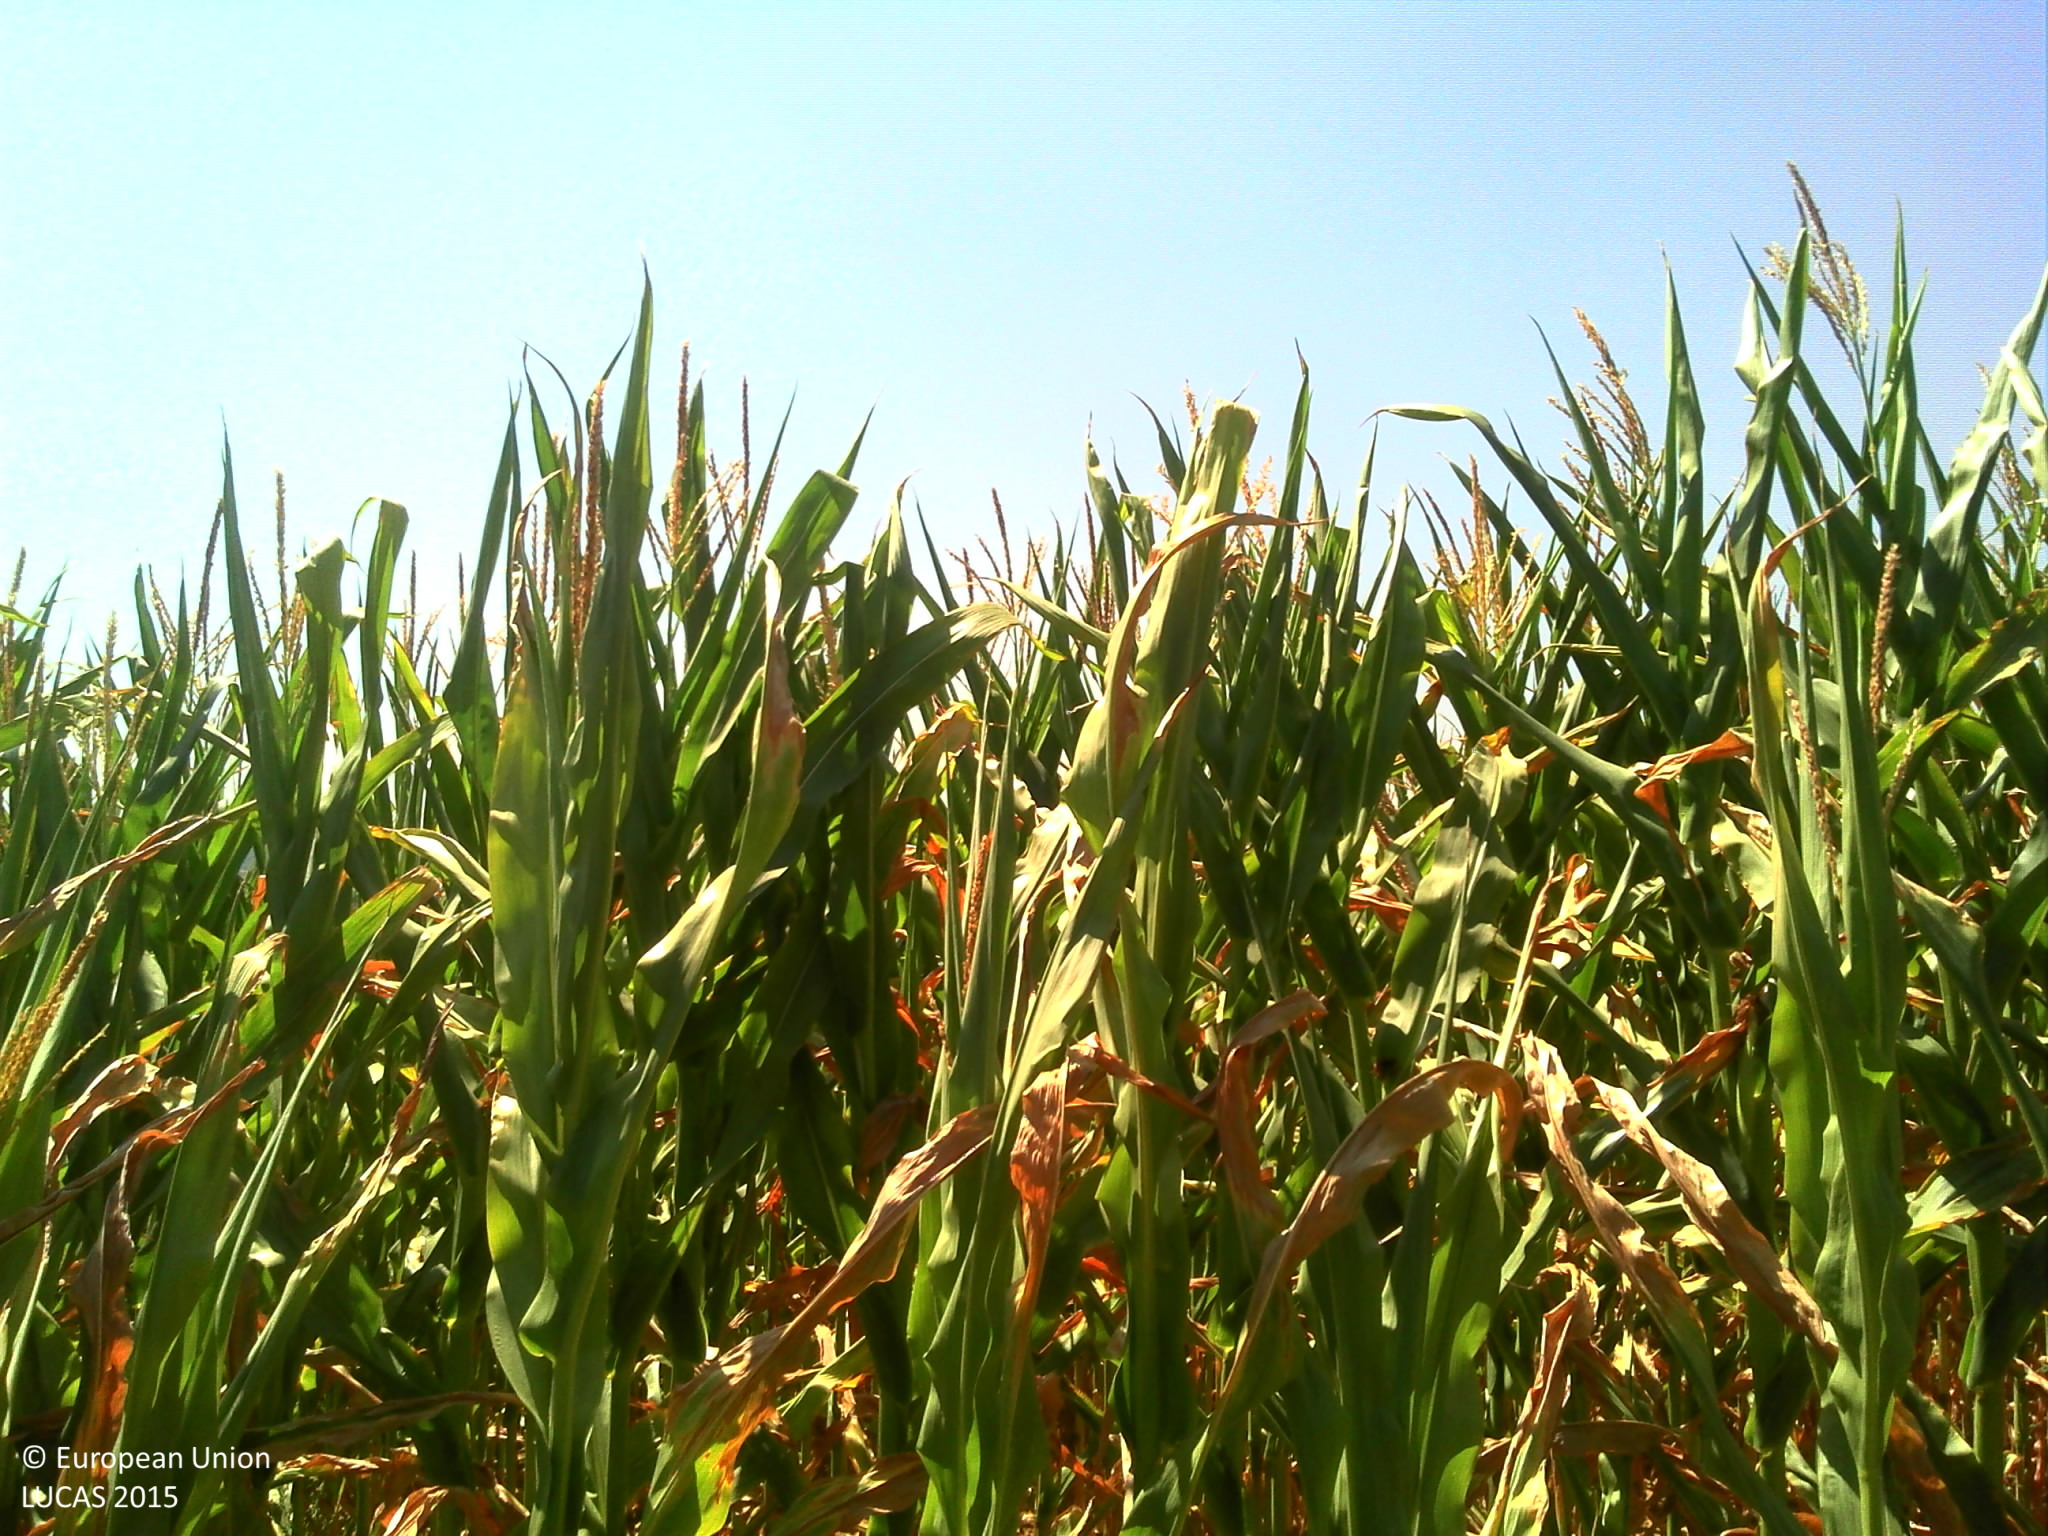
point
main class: Cropland
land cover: Maize
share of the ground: > 75 %
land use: Agriculture (excluding fallow land and kitchen gardens)
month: July
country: FR
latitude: 45.2006
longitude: 4.9001
